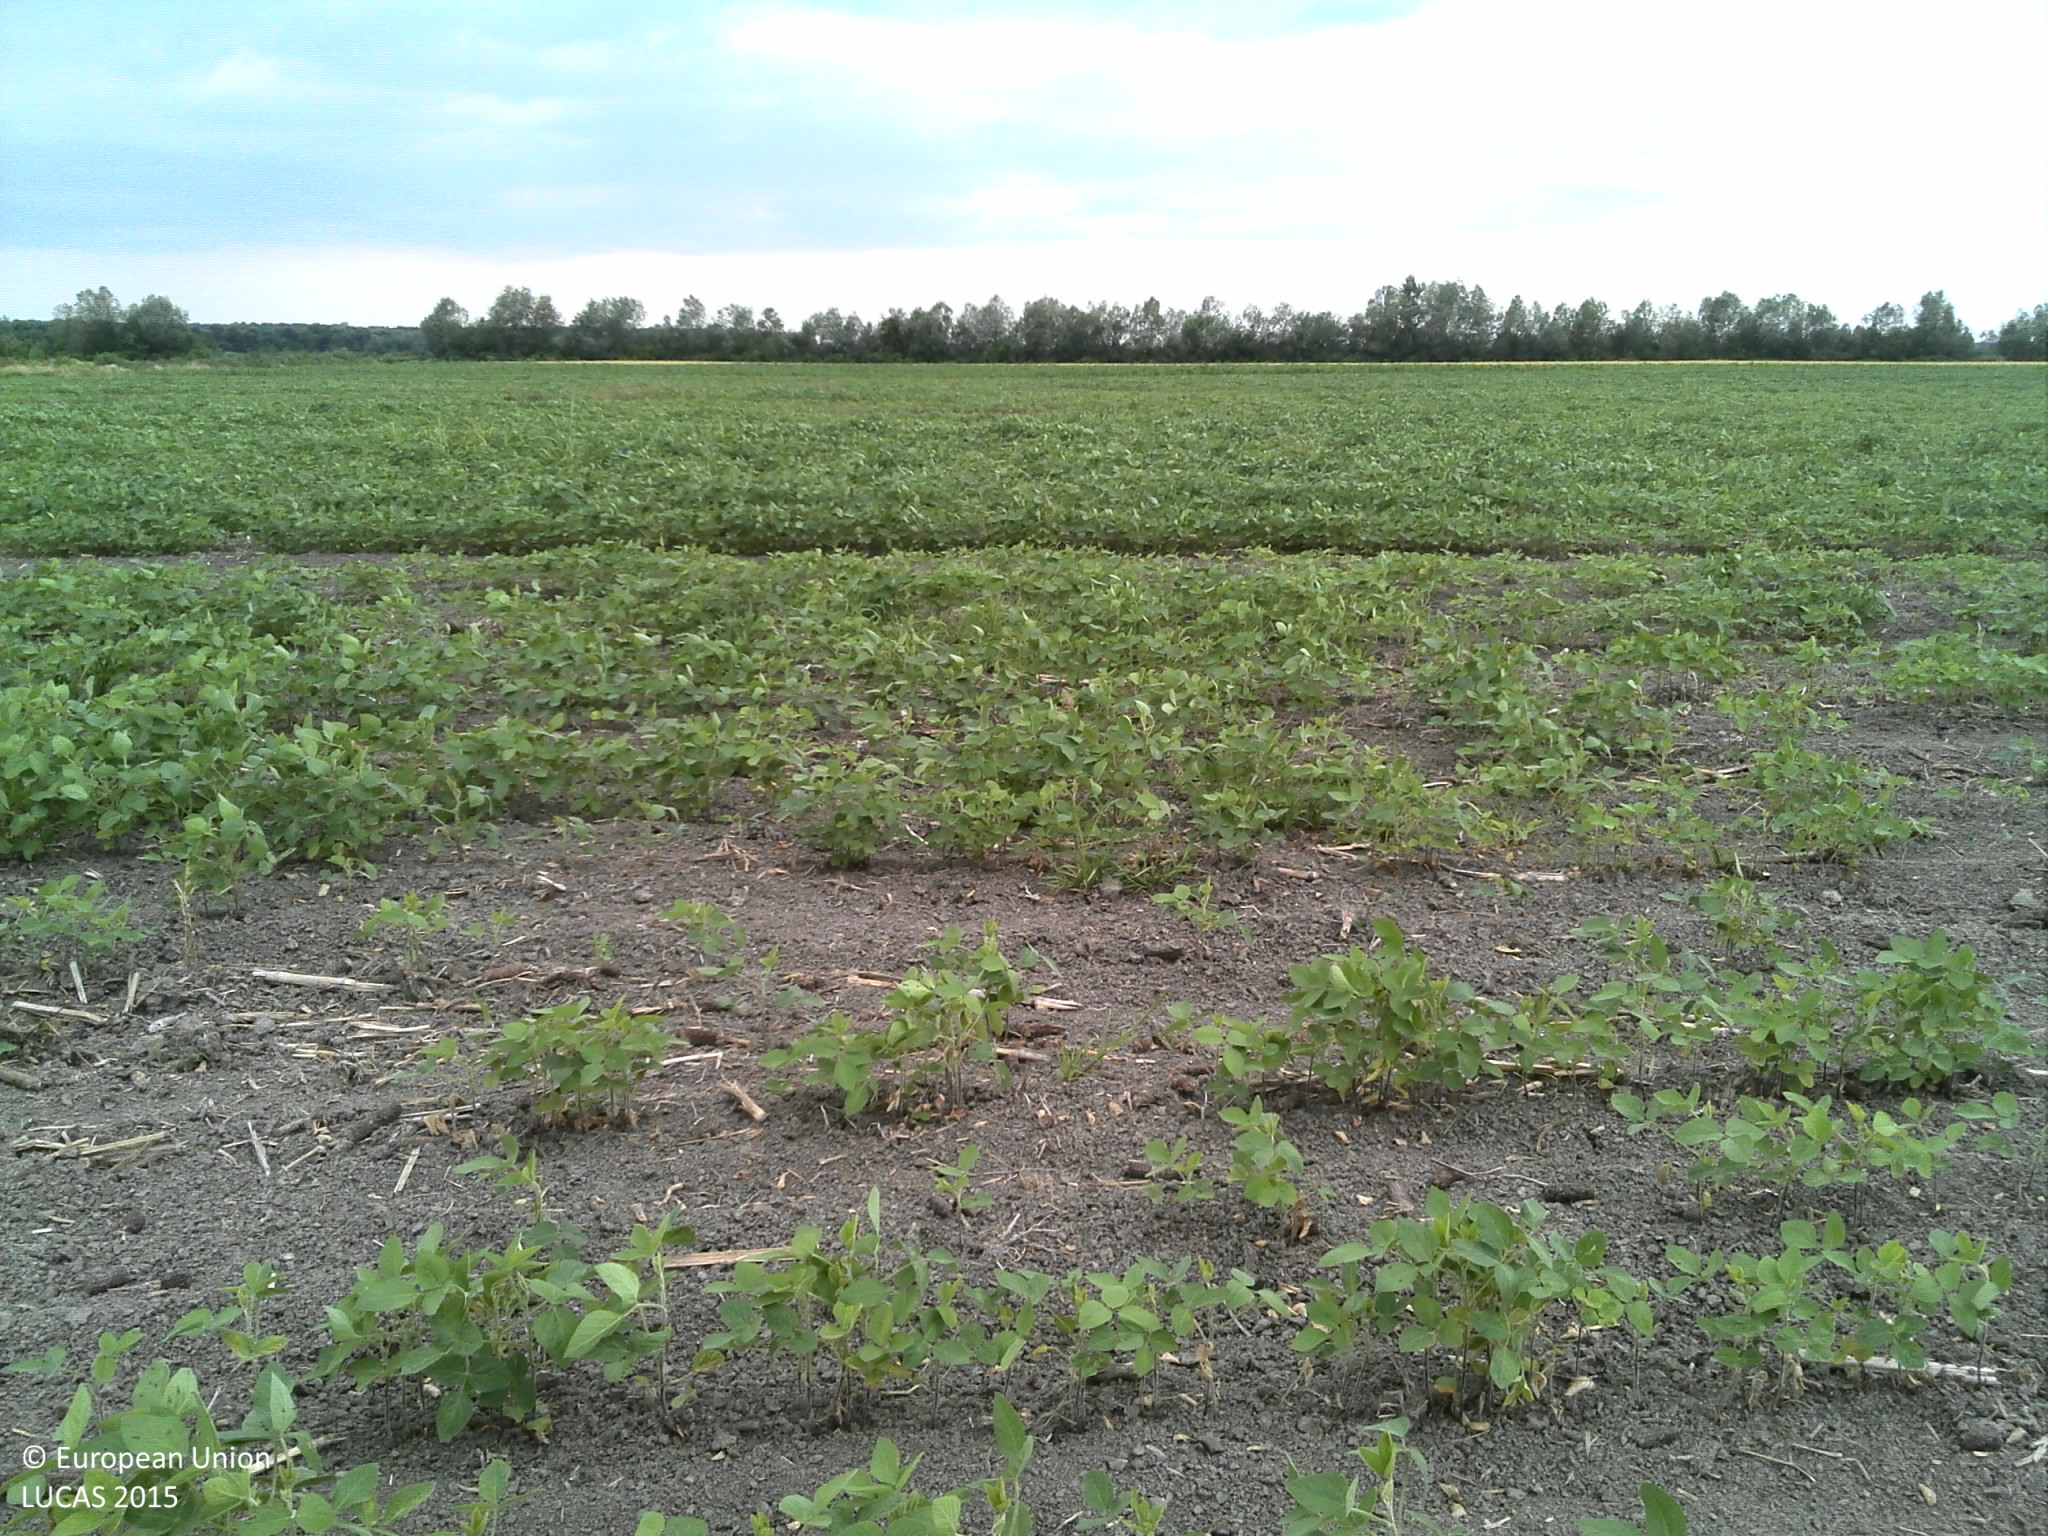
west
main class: Cropland
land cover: Soya
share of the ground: 25 - 50 %
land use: Agriculture (excluding fallow land and kitchen gardens)
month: June
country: HR
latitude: 45.1582
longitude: 17.5950
